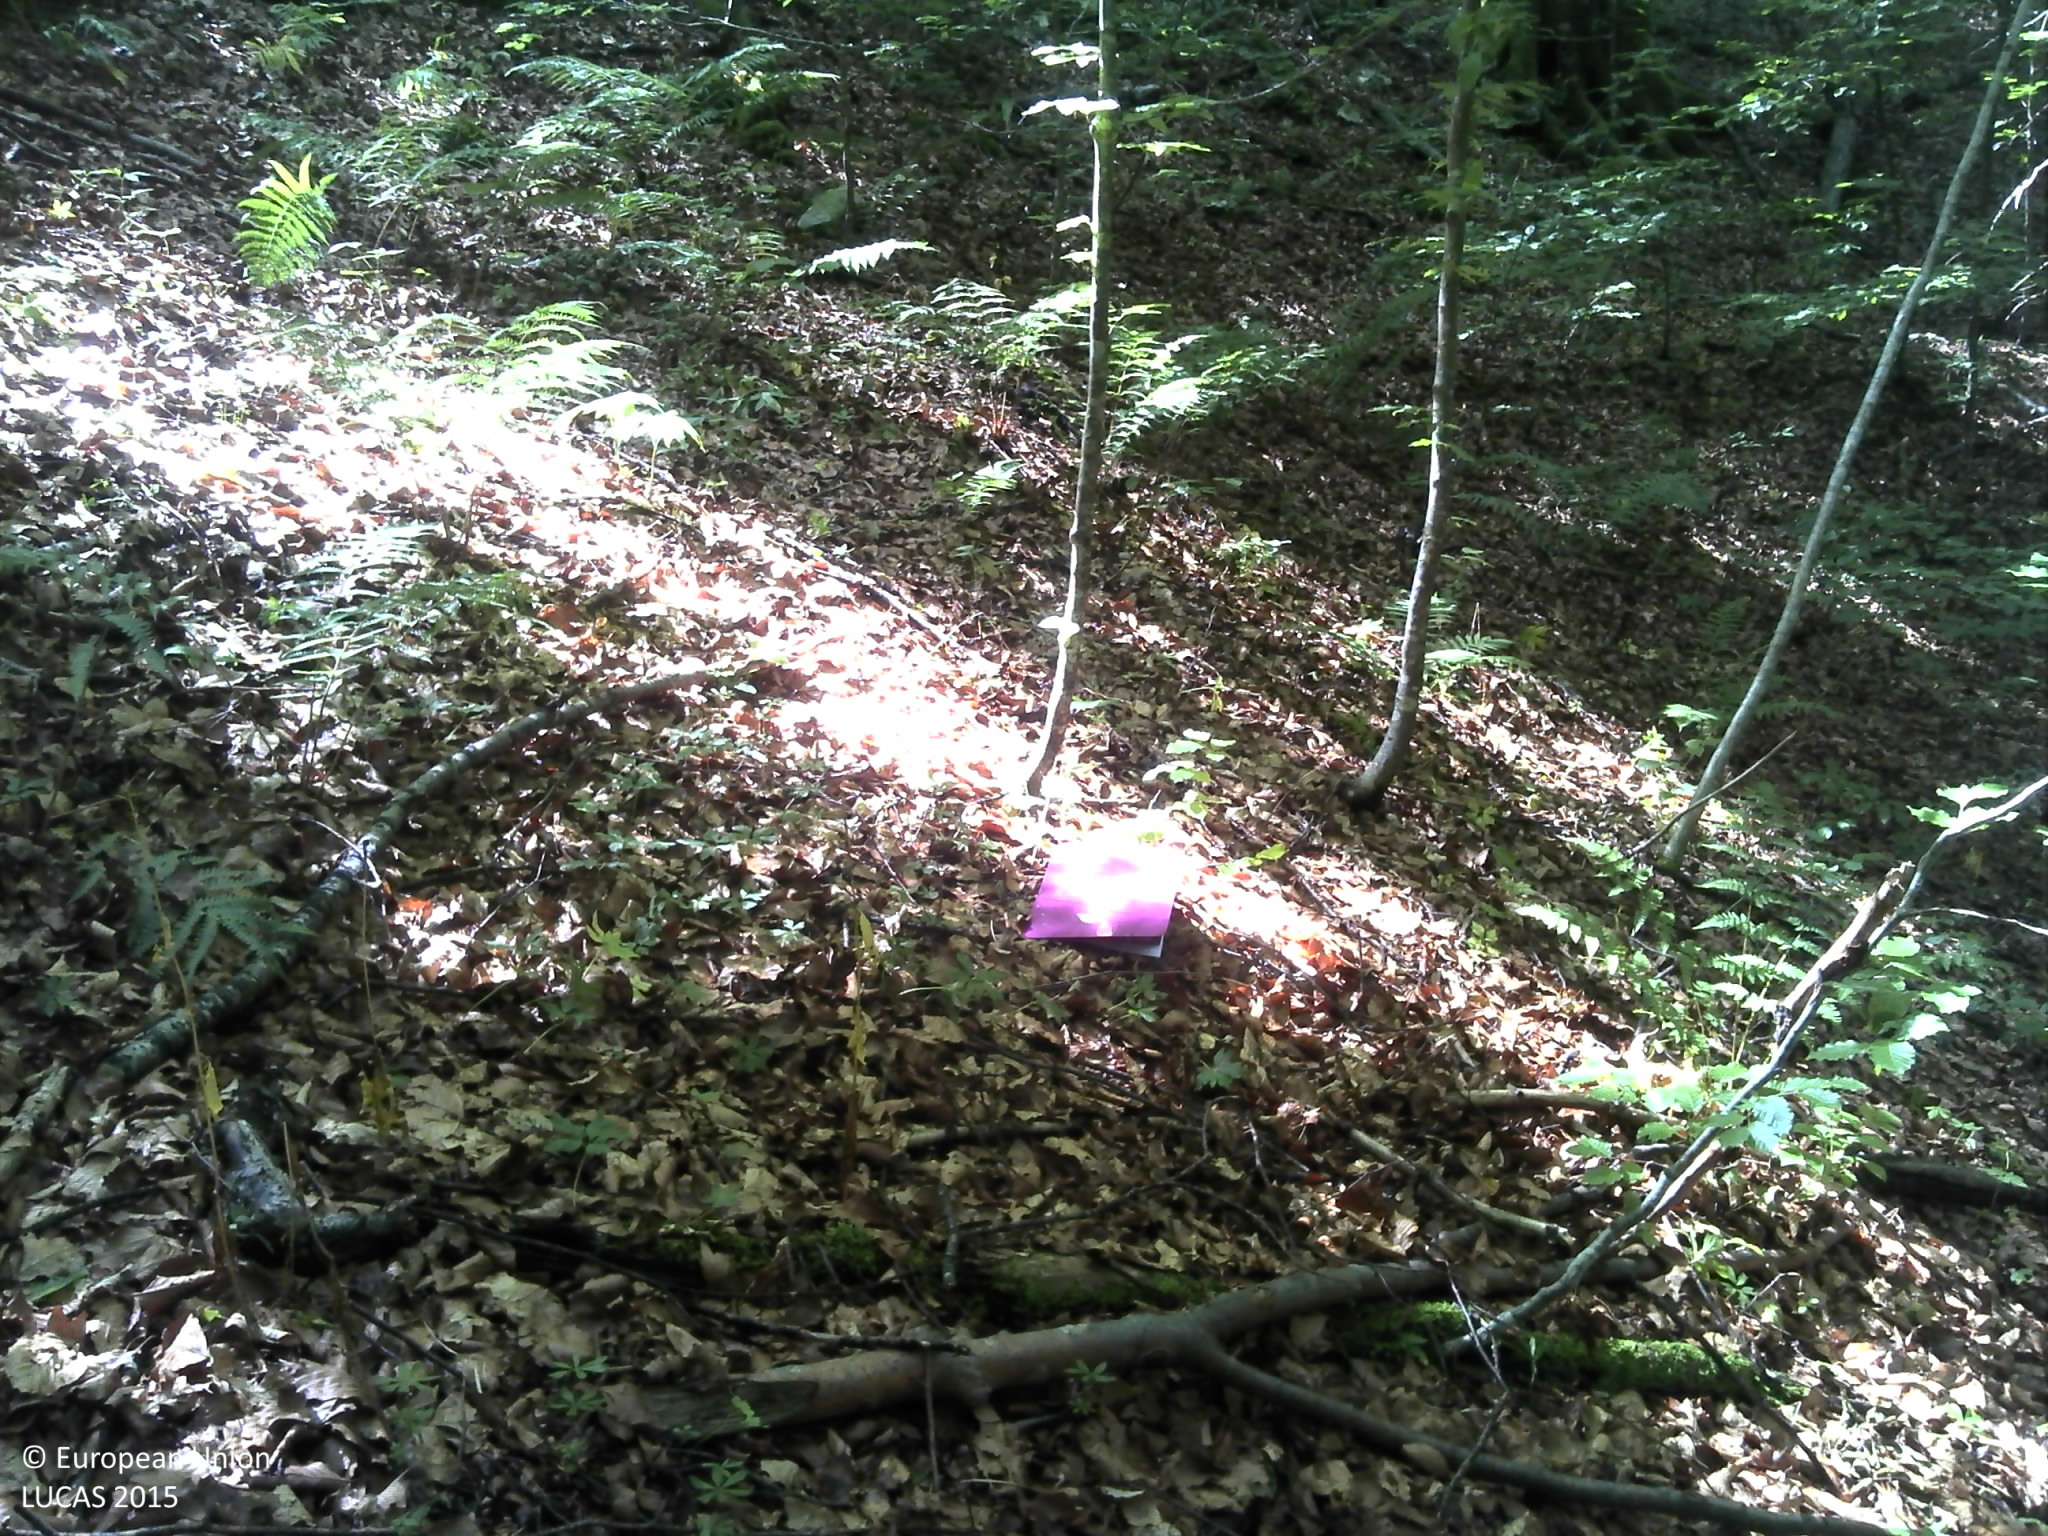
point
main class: Woodland
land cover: Broadleaved woodland
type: beech forest
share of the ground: > 75 %
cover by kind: broadleaved forest trees 95 %, consolidated bare surface 5 %
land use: Forestry
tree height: > 5 m
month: June
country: HR
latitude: 44.8845
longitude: 15.6285
